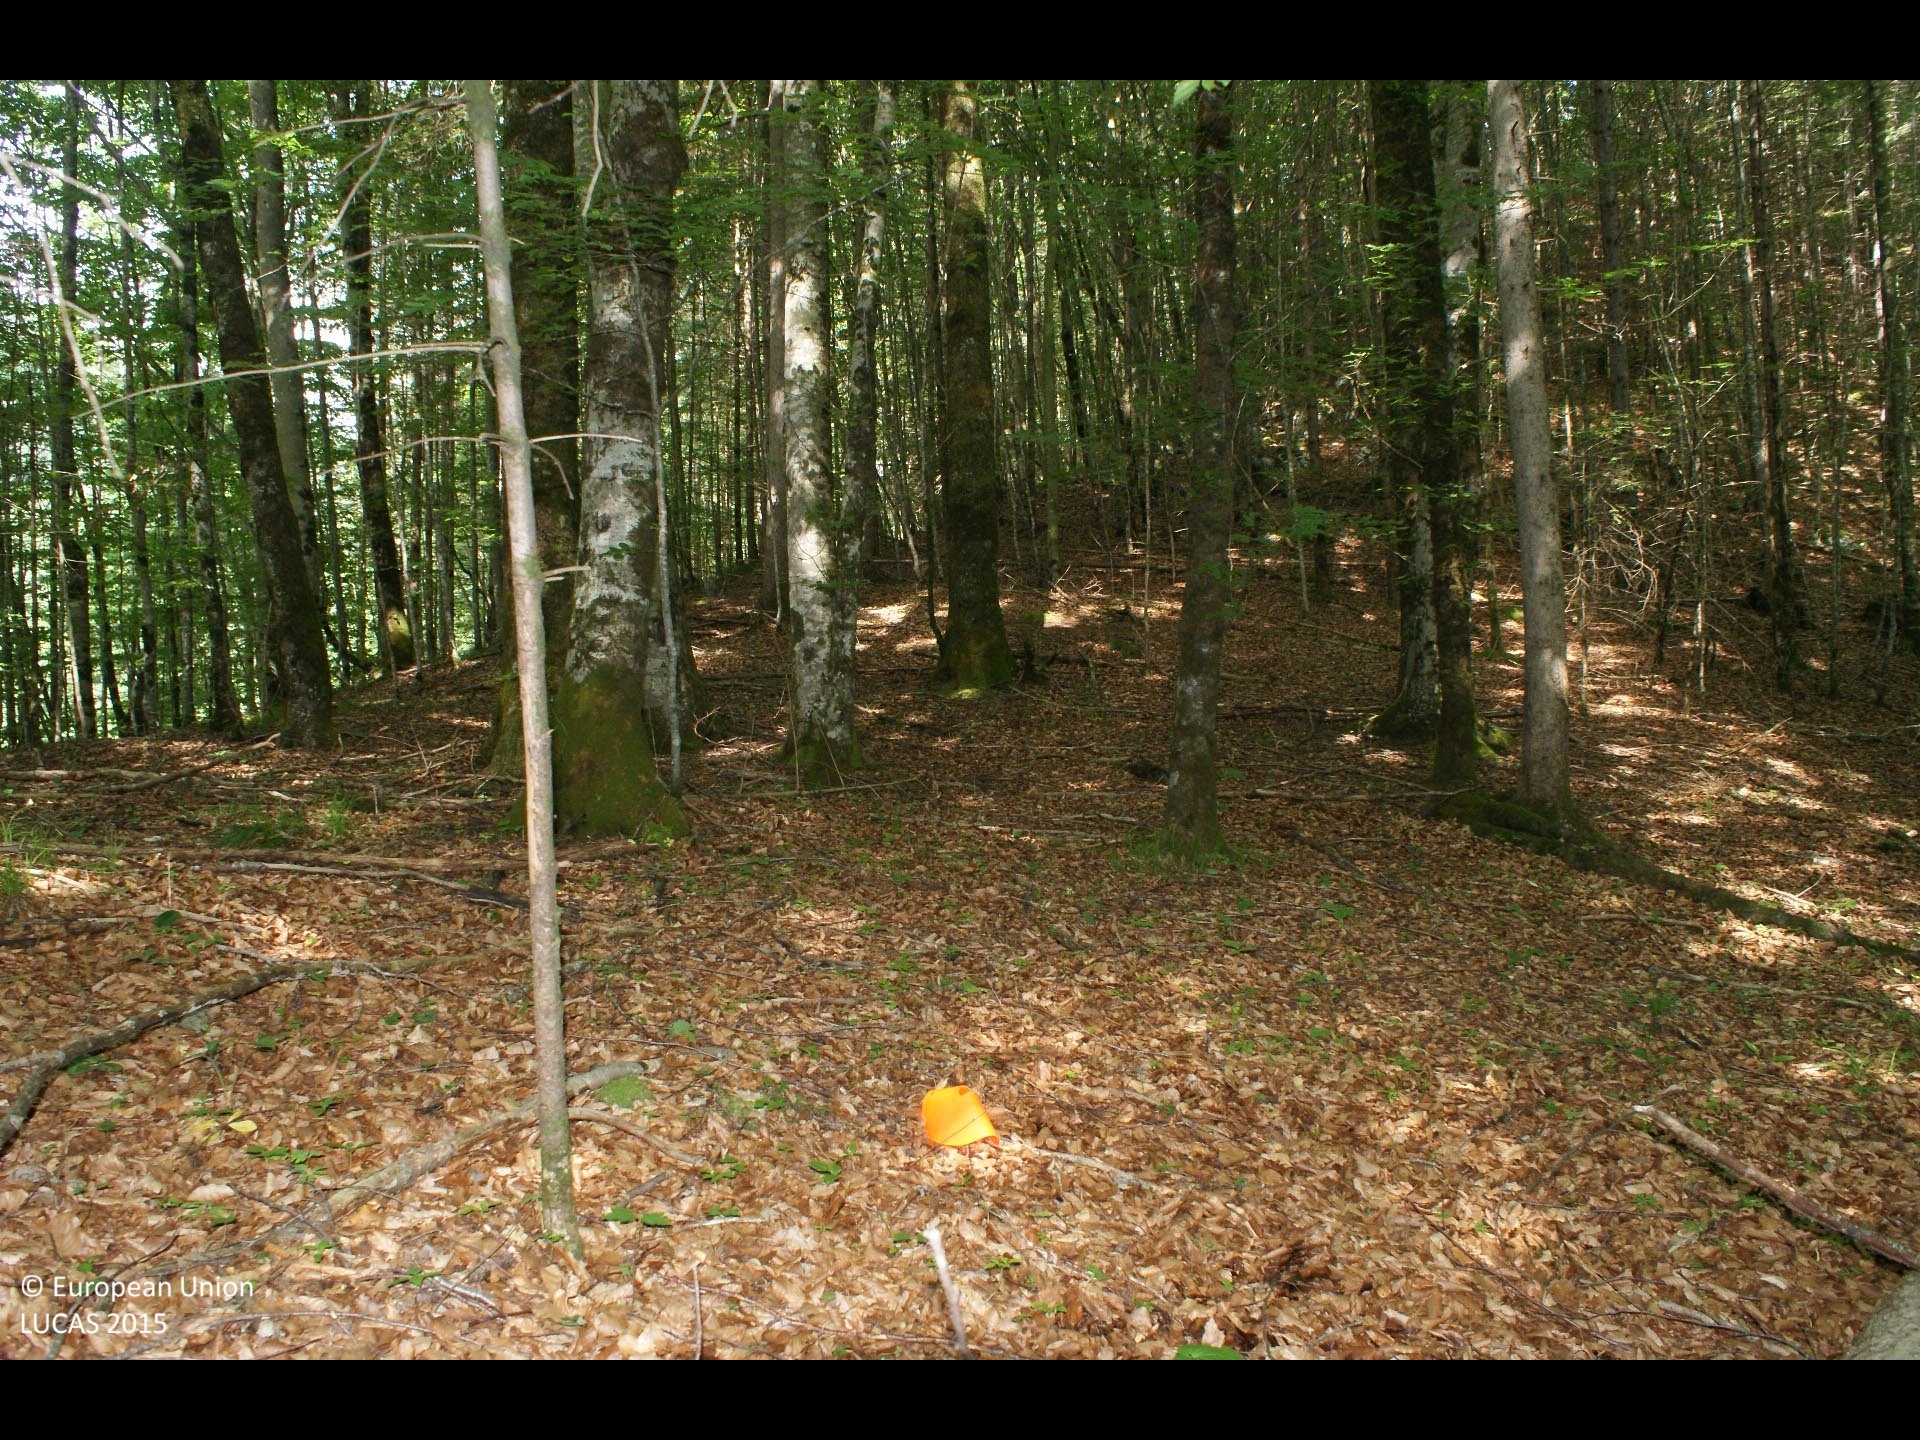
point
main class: Woodland
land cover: Broadleaved woodland
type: beech forest
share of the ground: > 75 %
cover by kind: broadleaved forest trees 90 %, coniferous forest trees 5 %, herbaceous plants 5 %
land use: Forestry
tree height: > 5 m
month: June
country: AT
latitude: 47.8030
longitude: 14.1517
